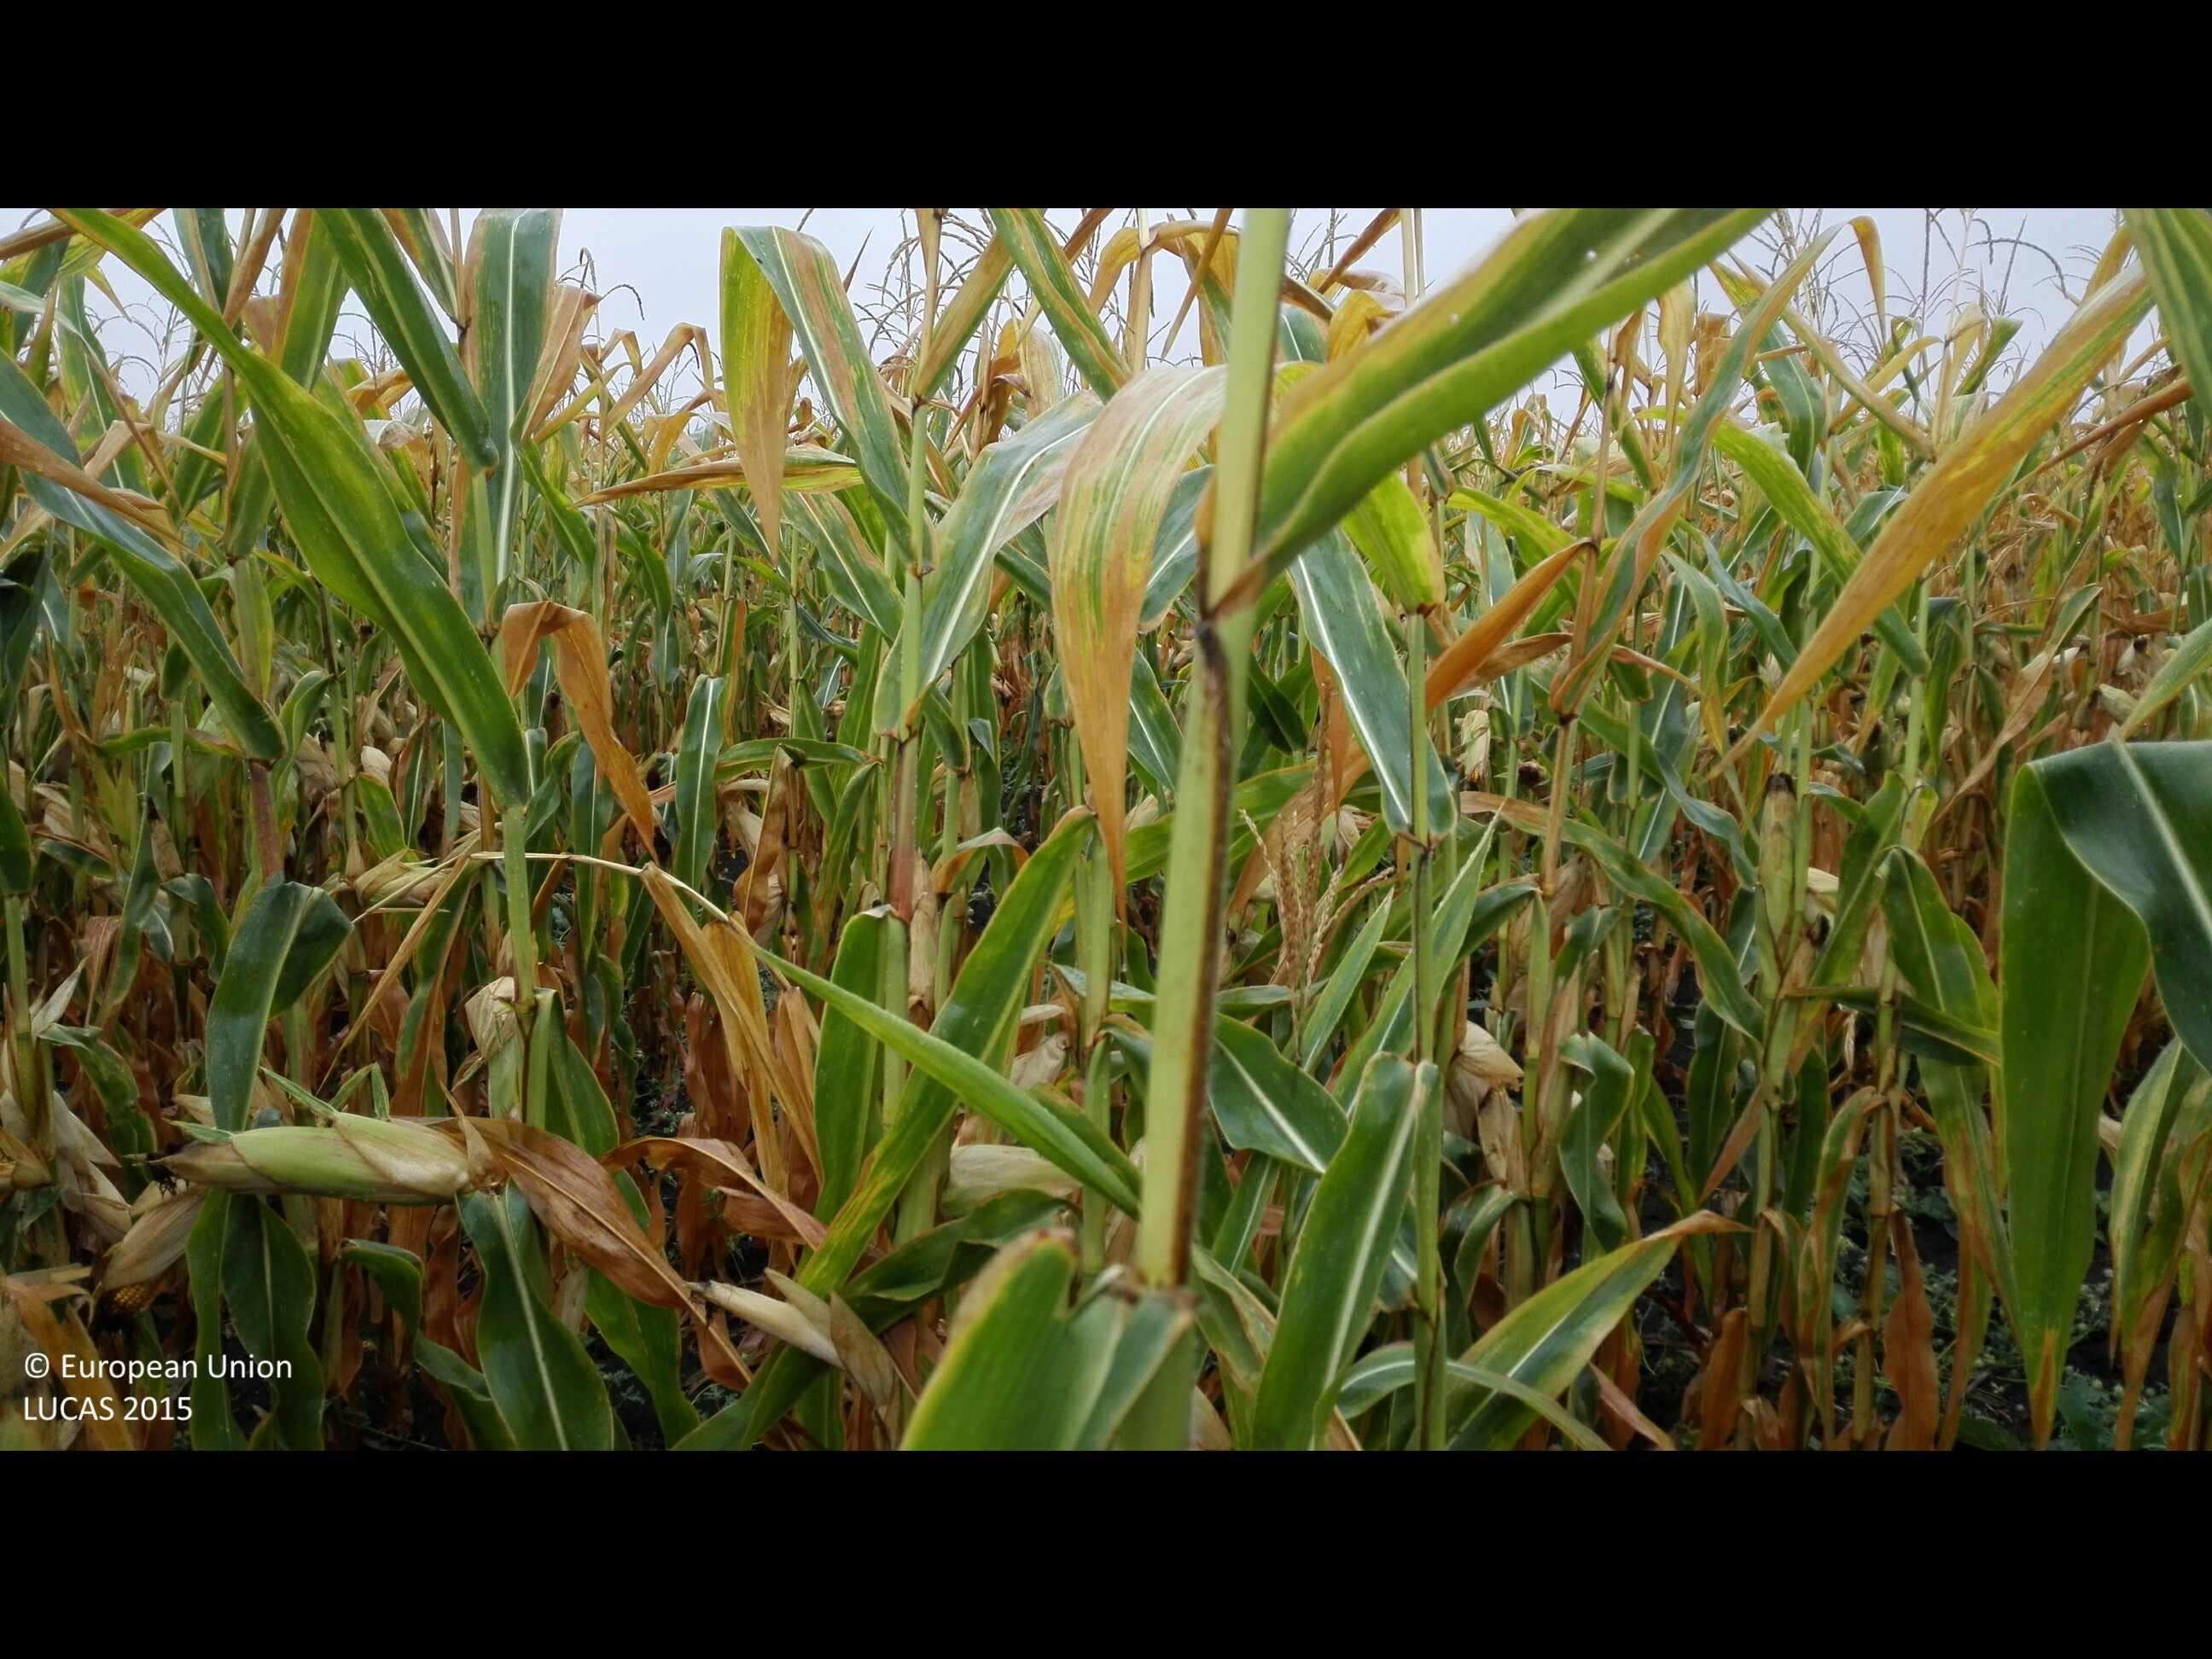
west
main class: Cropland
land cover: Maize
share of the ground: > 75 %
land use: Agriculture (excluding fallow land and kitchen gardens)
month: August
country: HU
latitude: 47.2216
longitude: 21.6513
